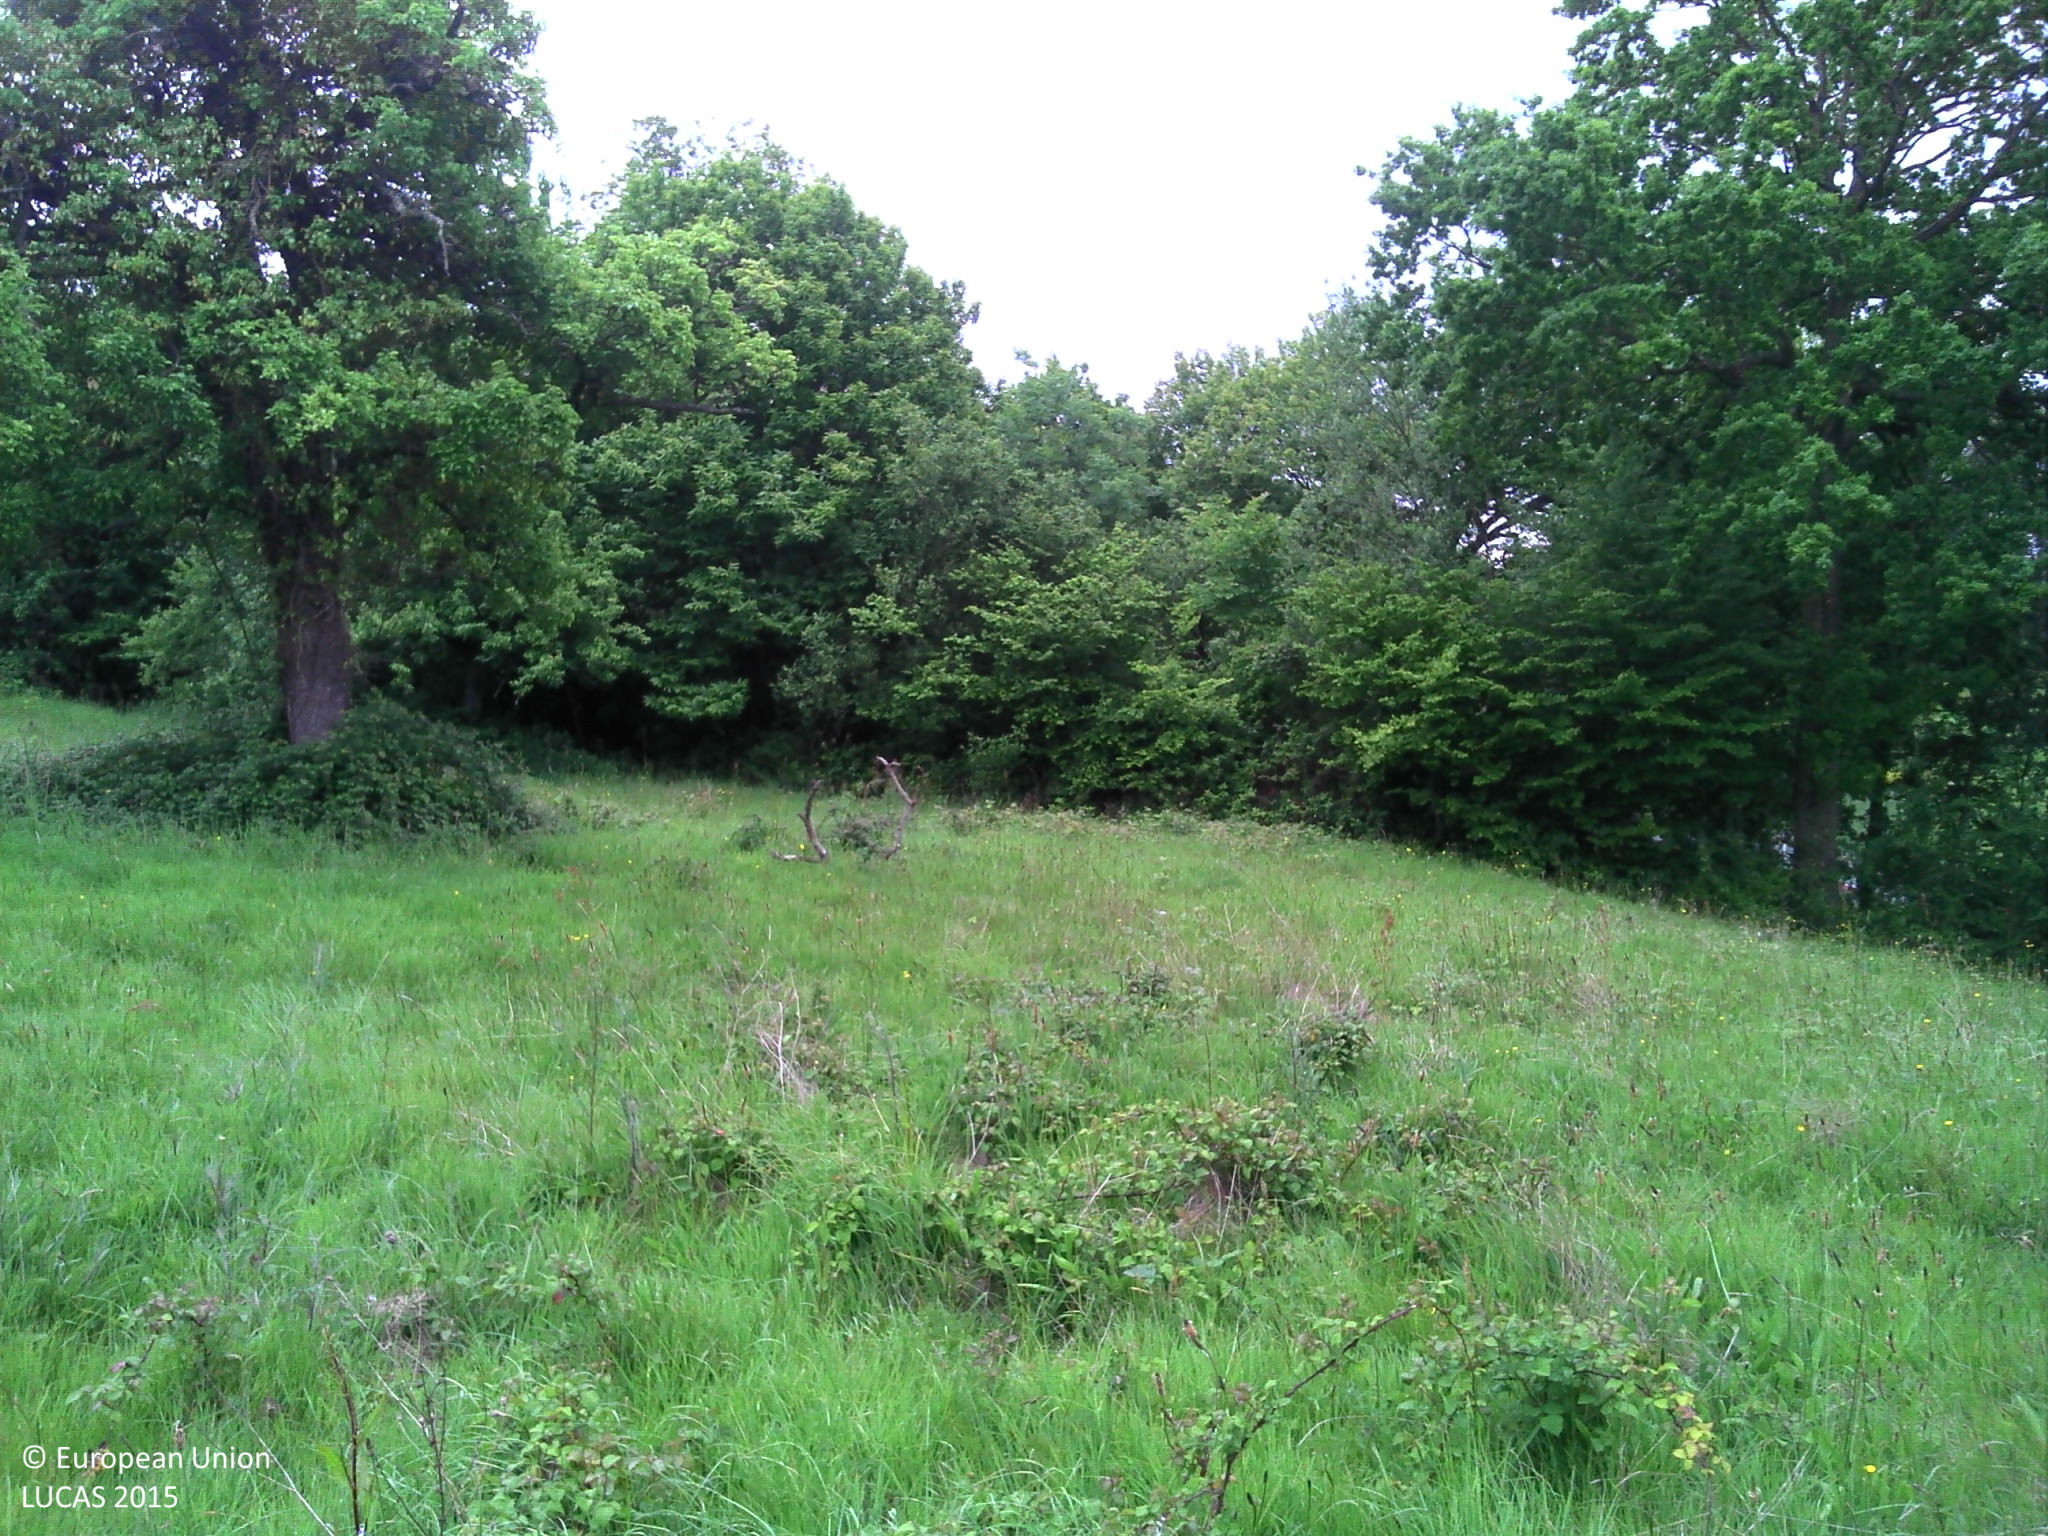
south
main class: Cropland
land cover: Pear fruit
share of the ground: < 10 %
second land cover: Grassland without tree/shrub cover
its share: > 75 %
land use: Agriculture (excluding fallow land and kitchen gardens)
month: May
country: FR
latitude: 49.2905
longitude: 0.0006
